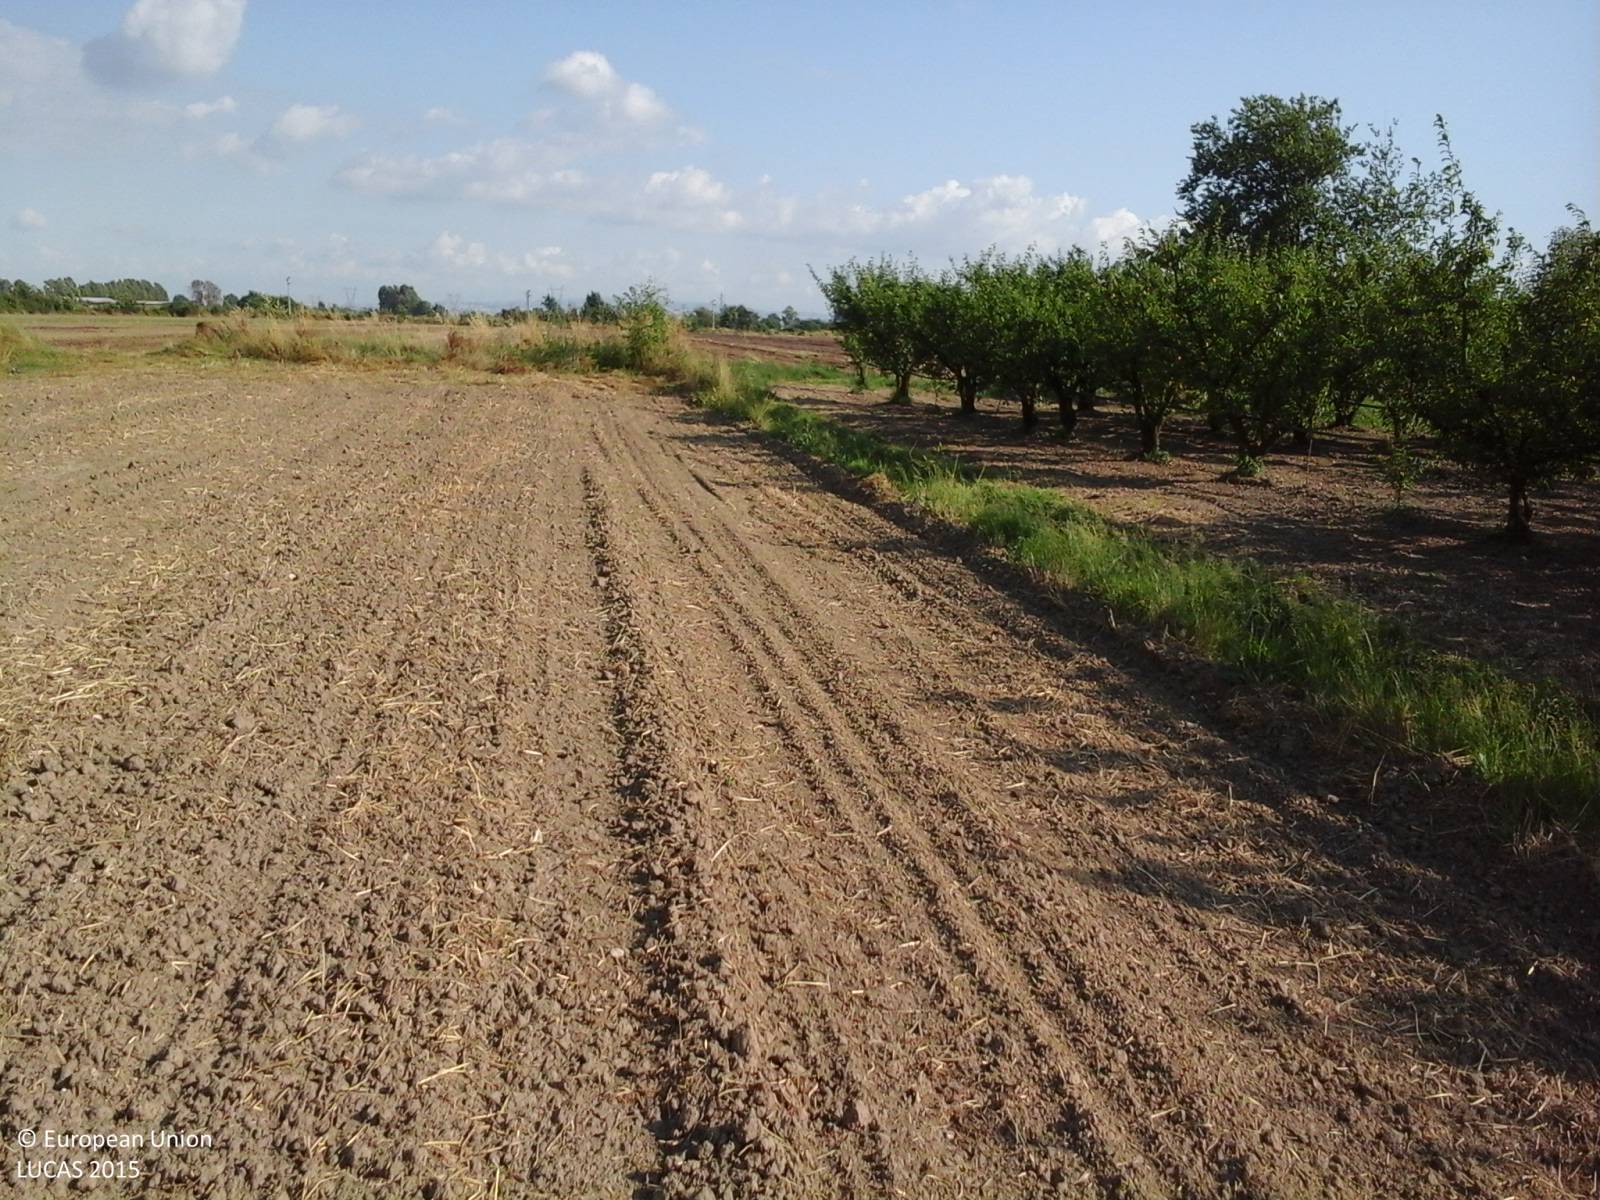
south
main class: Cropland
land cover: Temporary grasslands
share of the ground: < 10 %
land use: Agriculture (excluding fallow land and kitchen gardens)
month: June
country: IT
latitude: 41.0858
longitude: 14.1378
